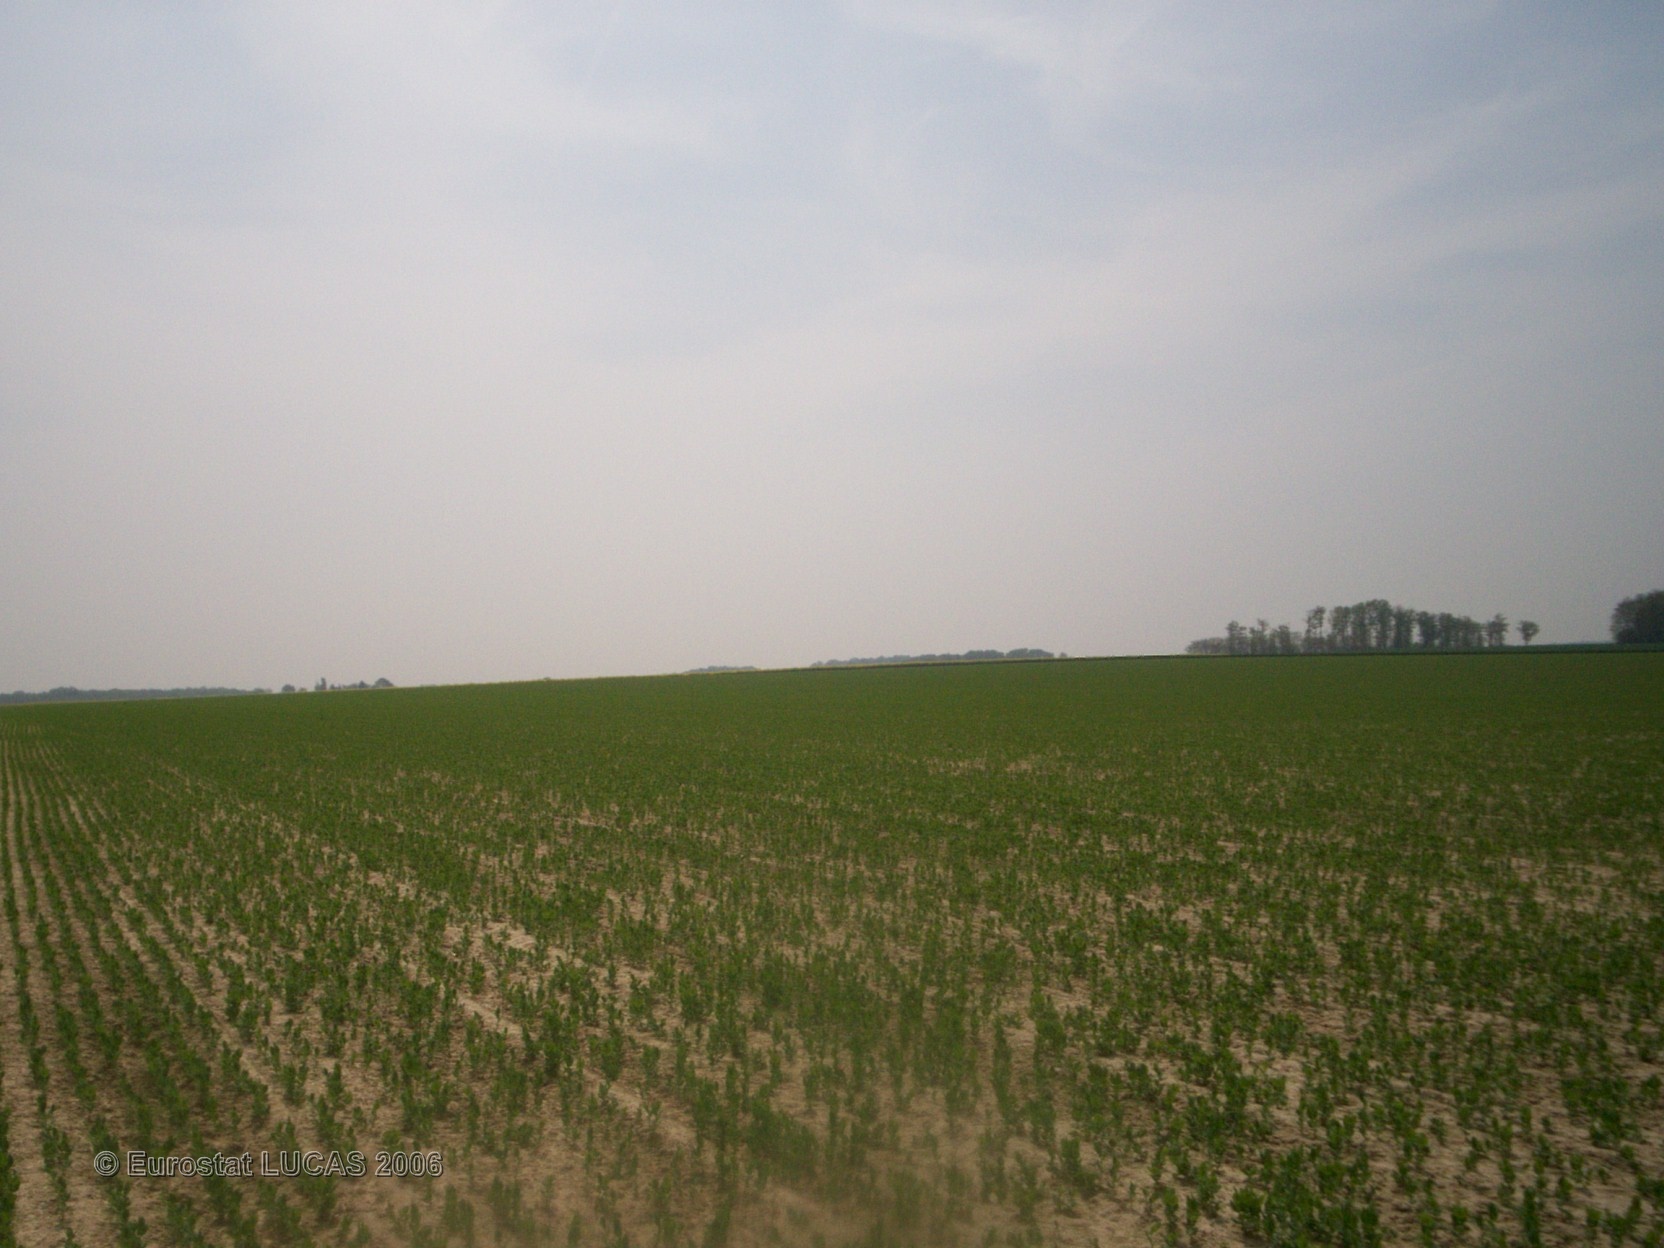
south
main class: Cropland
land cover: Dry pulses
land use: Agriculture (excluding fallow land and kitchen gardens)
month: May
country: FR
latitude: 47.9086
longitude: 2.9690
